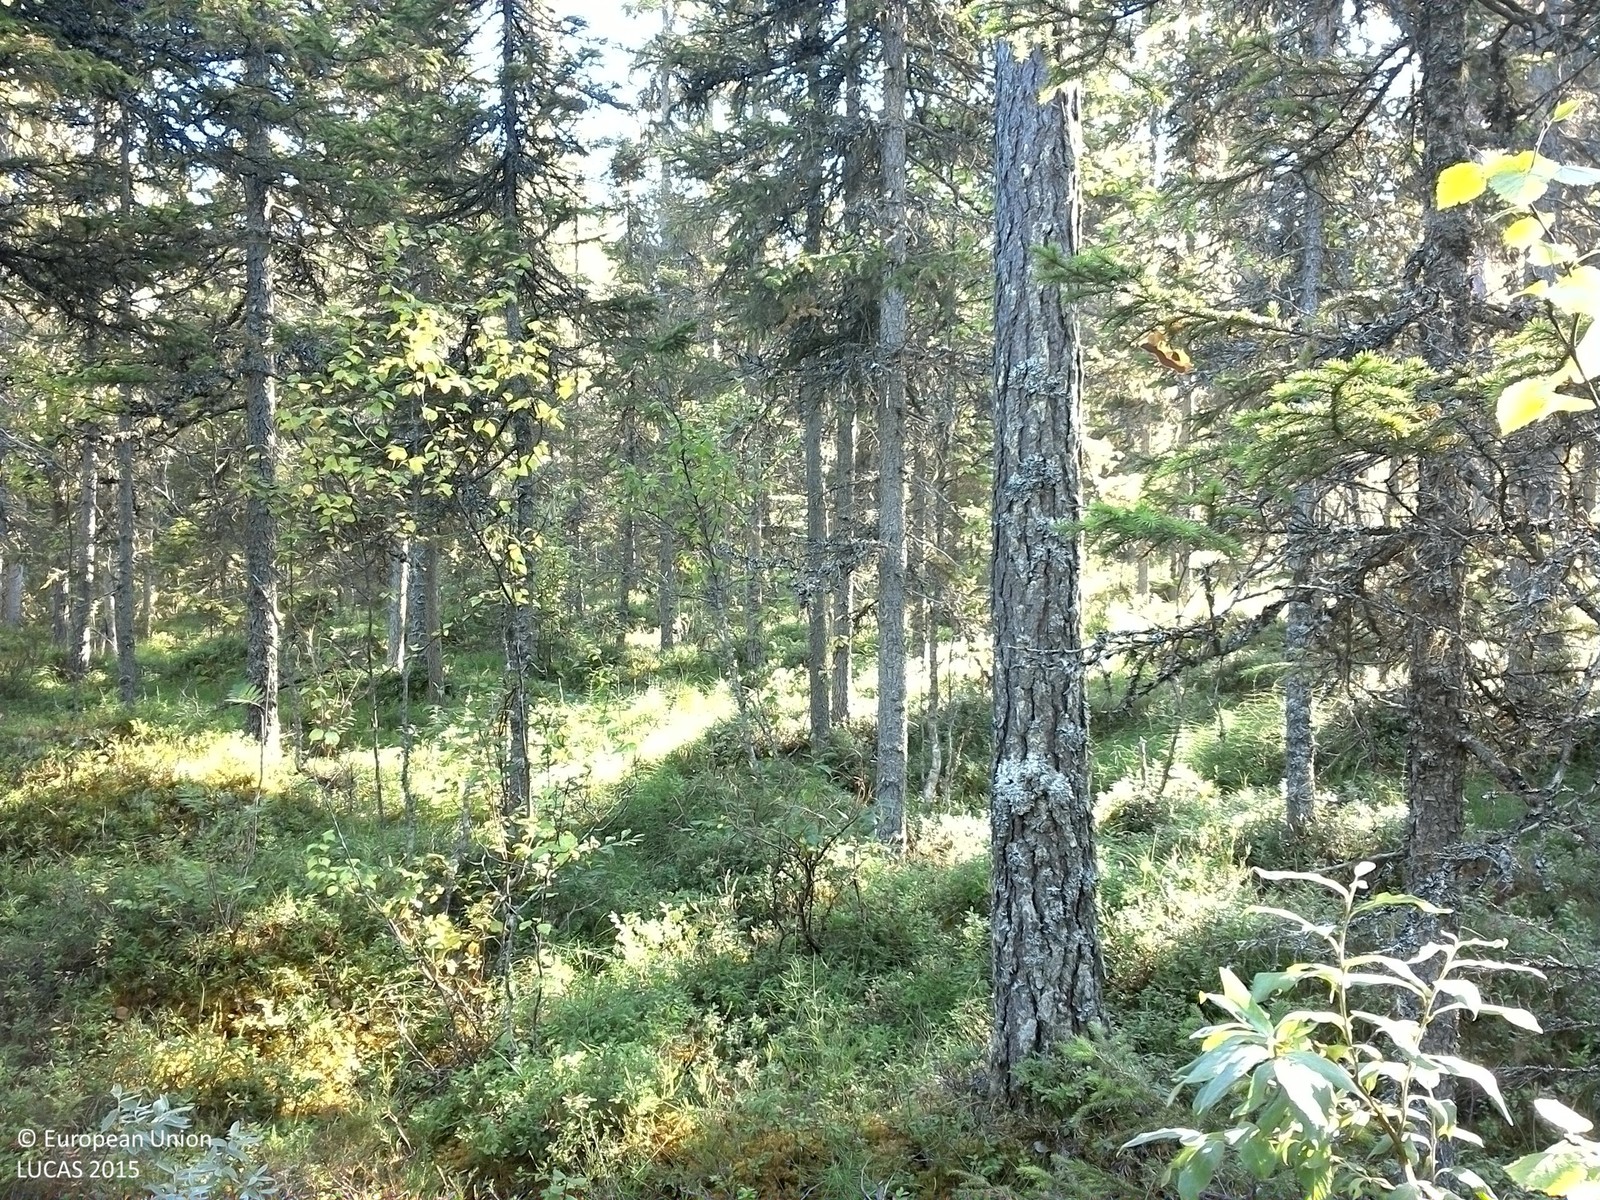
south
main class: Woodland
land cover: Other coniferous woodland
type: boreal forest
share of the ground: 50 - 75 %
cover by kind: coniferous forest trees 50 %, shrubs 35 %, lichens and mosses 10 %, broadleaved forest trees 5 %
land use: Forestry
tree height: > 5 m
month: September
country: SE
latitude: 63.8594
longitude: 16.6647
